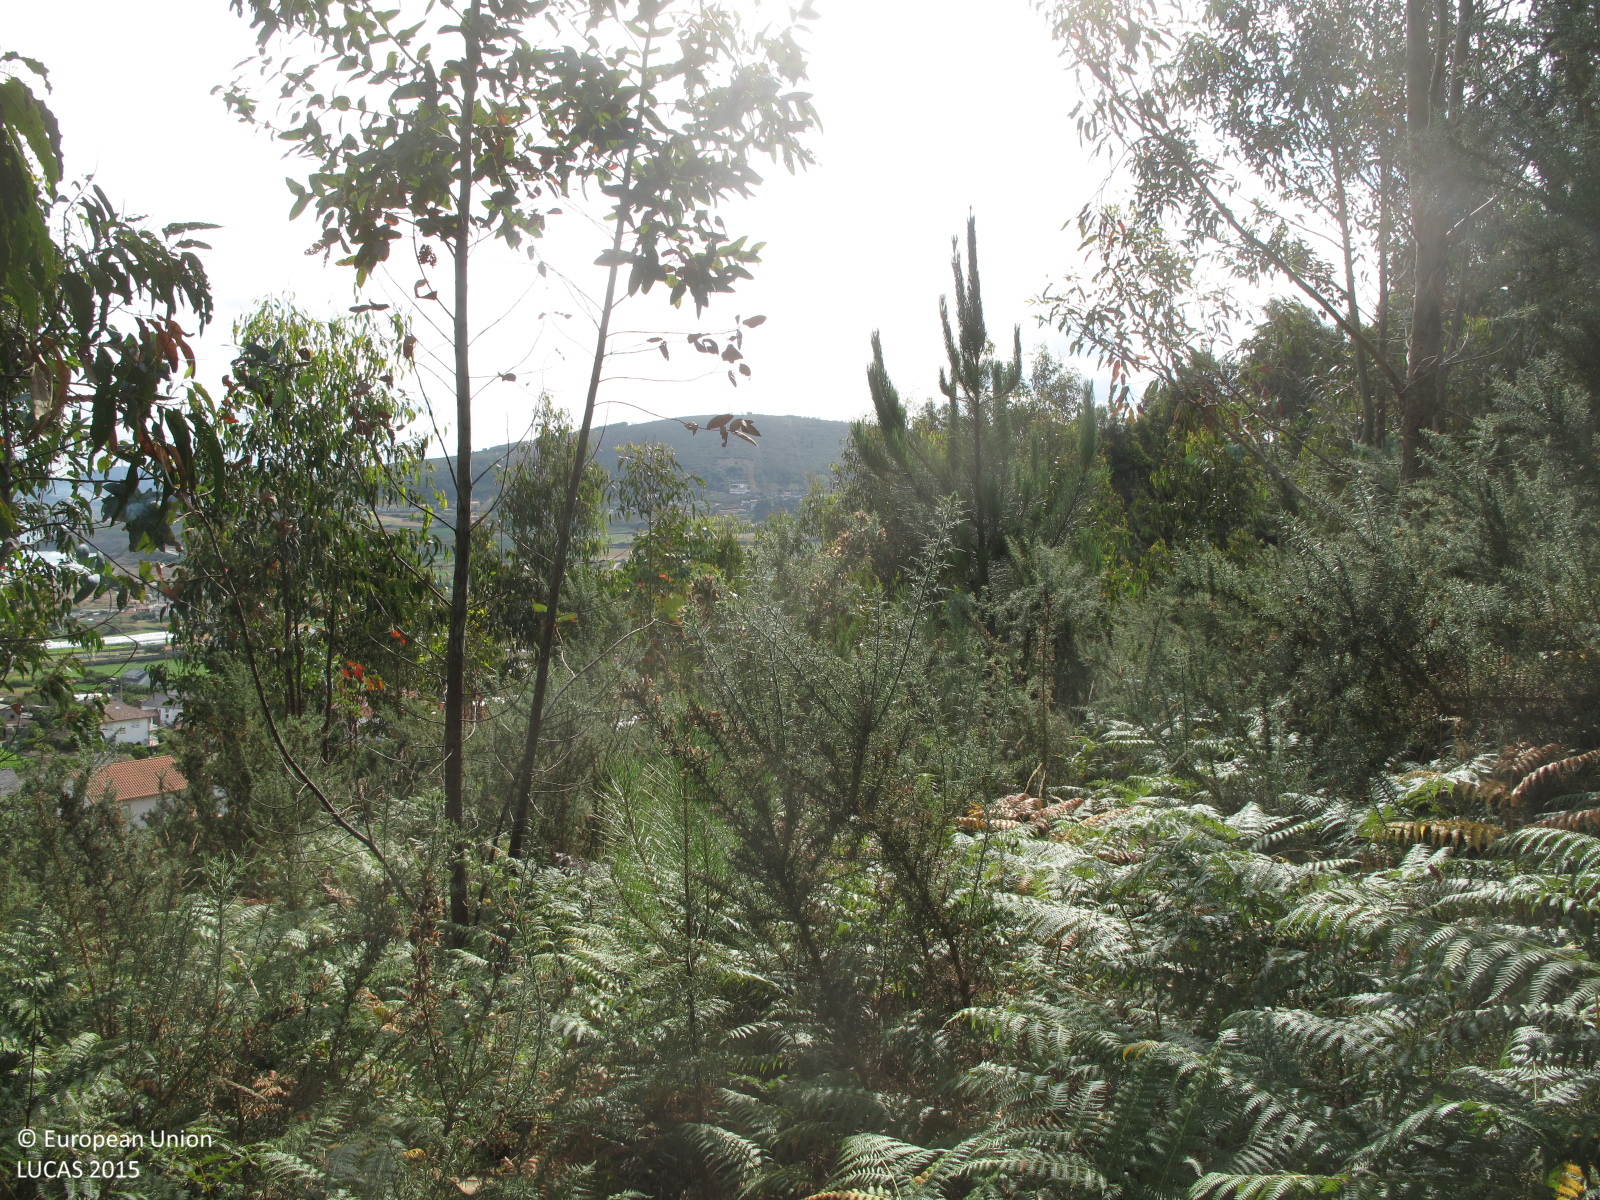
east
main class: Woodland
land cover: Other mixed woodland
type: exotic forest
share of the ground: 25 - 50 %
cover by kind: broadleaved forest trees 30 %, shrubs 30 %, coniferous forest trees 20 %, herbaceous plants 20 %
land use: Forestry
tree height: > 5 m
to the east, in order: Other mixed woodland; Broadleaved woodland; Tracks; Other mixed woodland; Grassland with sparse tree/shrub cover; Broadleaved woodland; Artificial constructions in urban areas; Shrubland without tree cover; Electric lines; Paved roads, cycling and walking lanes; Other bare soil; Other mixed woodland; Shrubland without tree cover
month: July
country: ES
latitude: 43.3035
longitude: -8.5655
